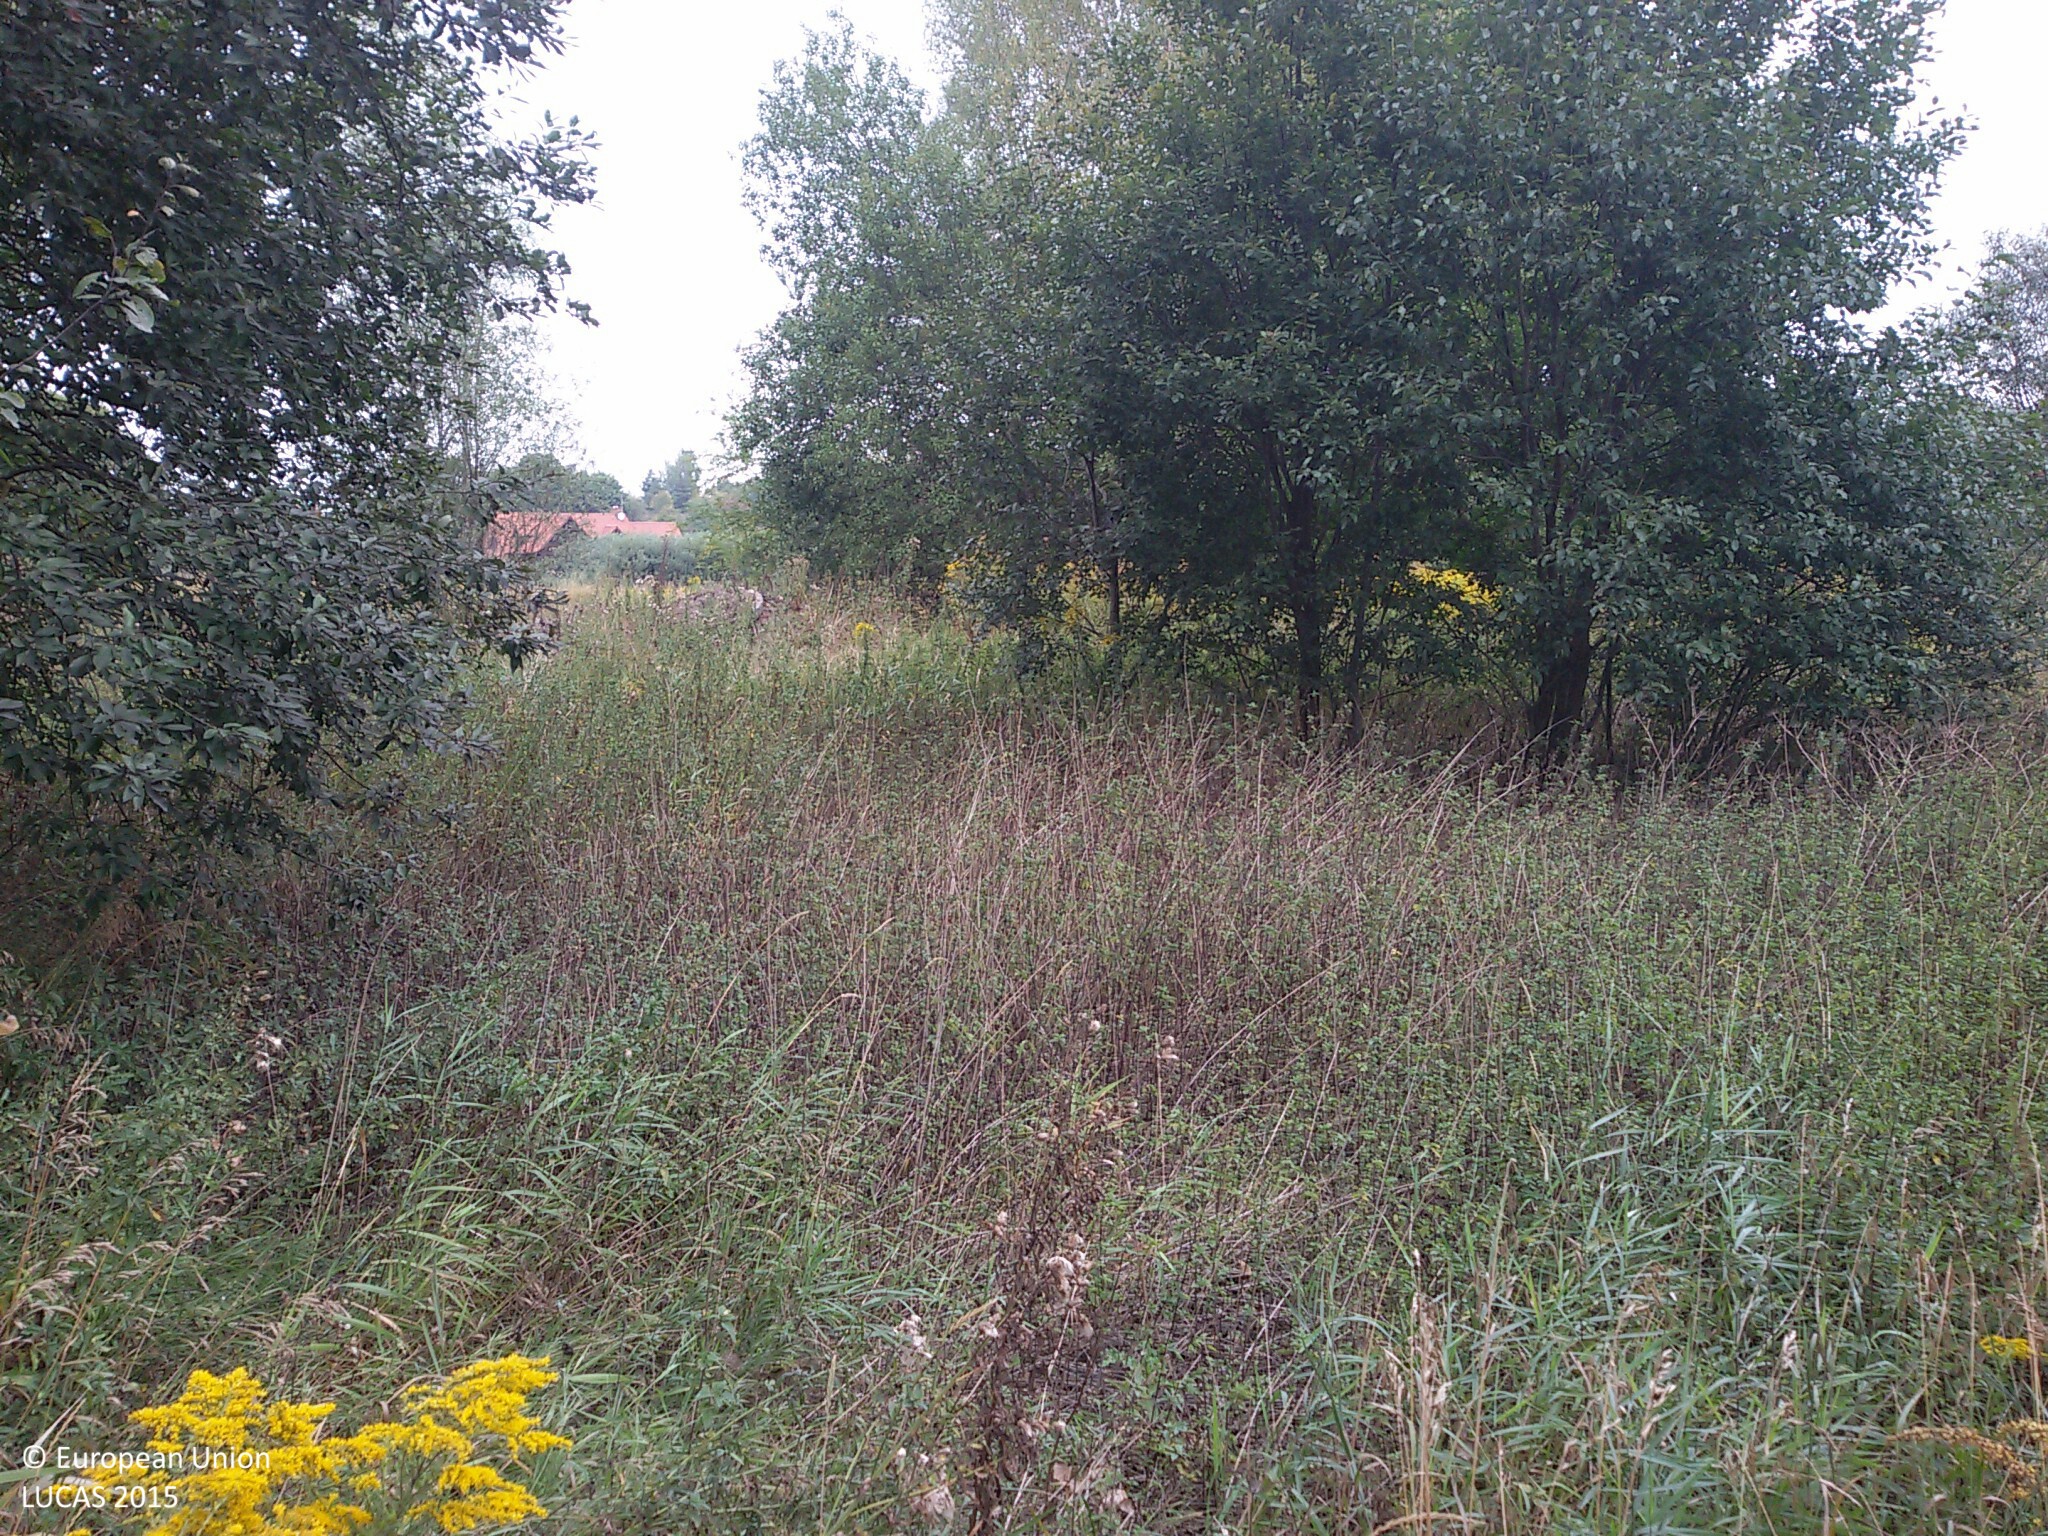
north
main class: Grassland
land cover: Grassland with sparse tree/shrub cover
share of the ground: > 75 %
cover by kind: herbaceous plants 85 %, shrubs 10 %, broadleaved forest trees 5 %
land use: Abandoned areas
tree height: > 5 m
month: September
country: PL
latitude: 53.7311
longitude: 20.2047
